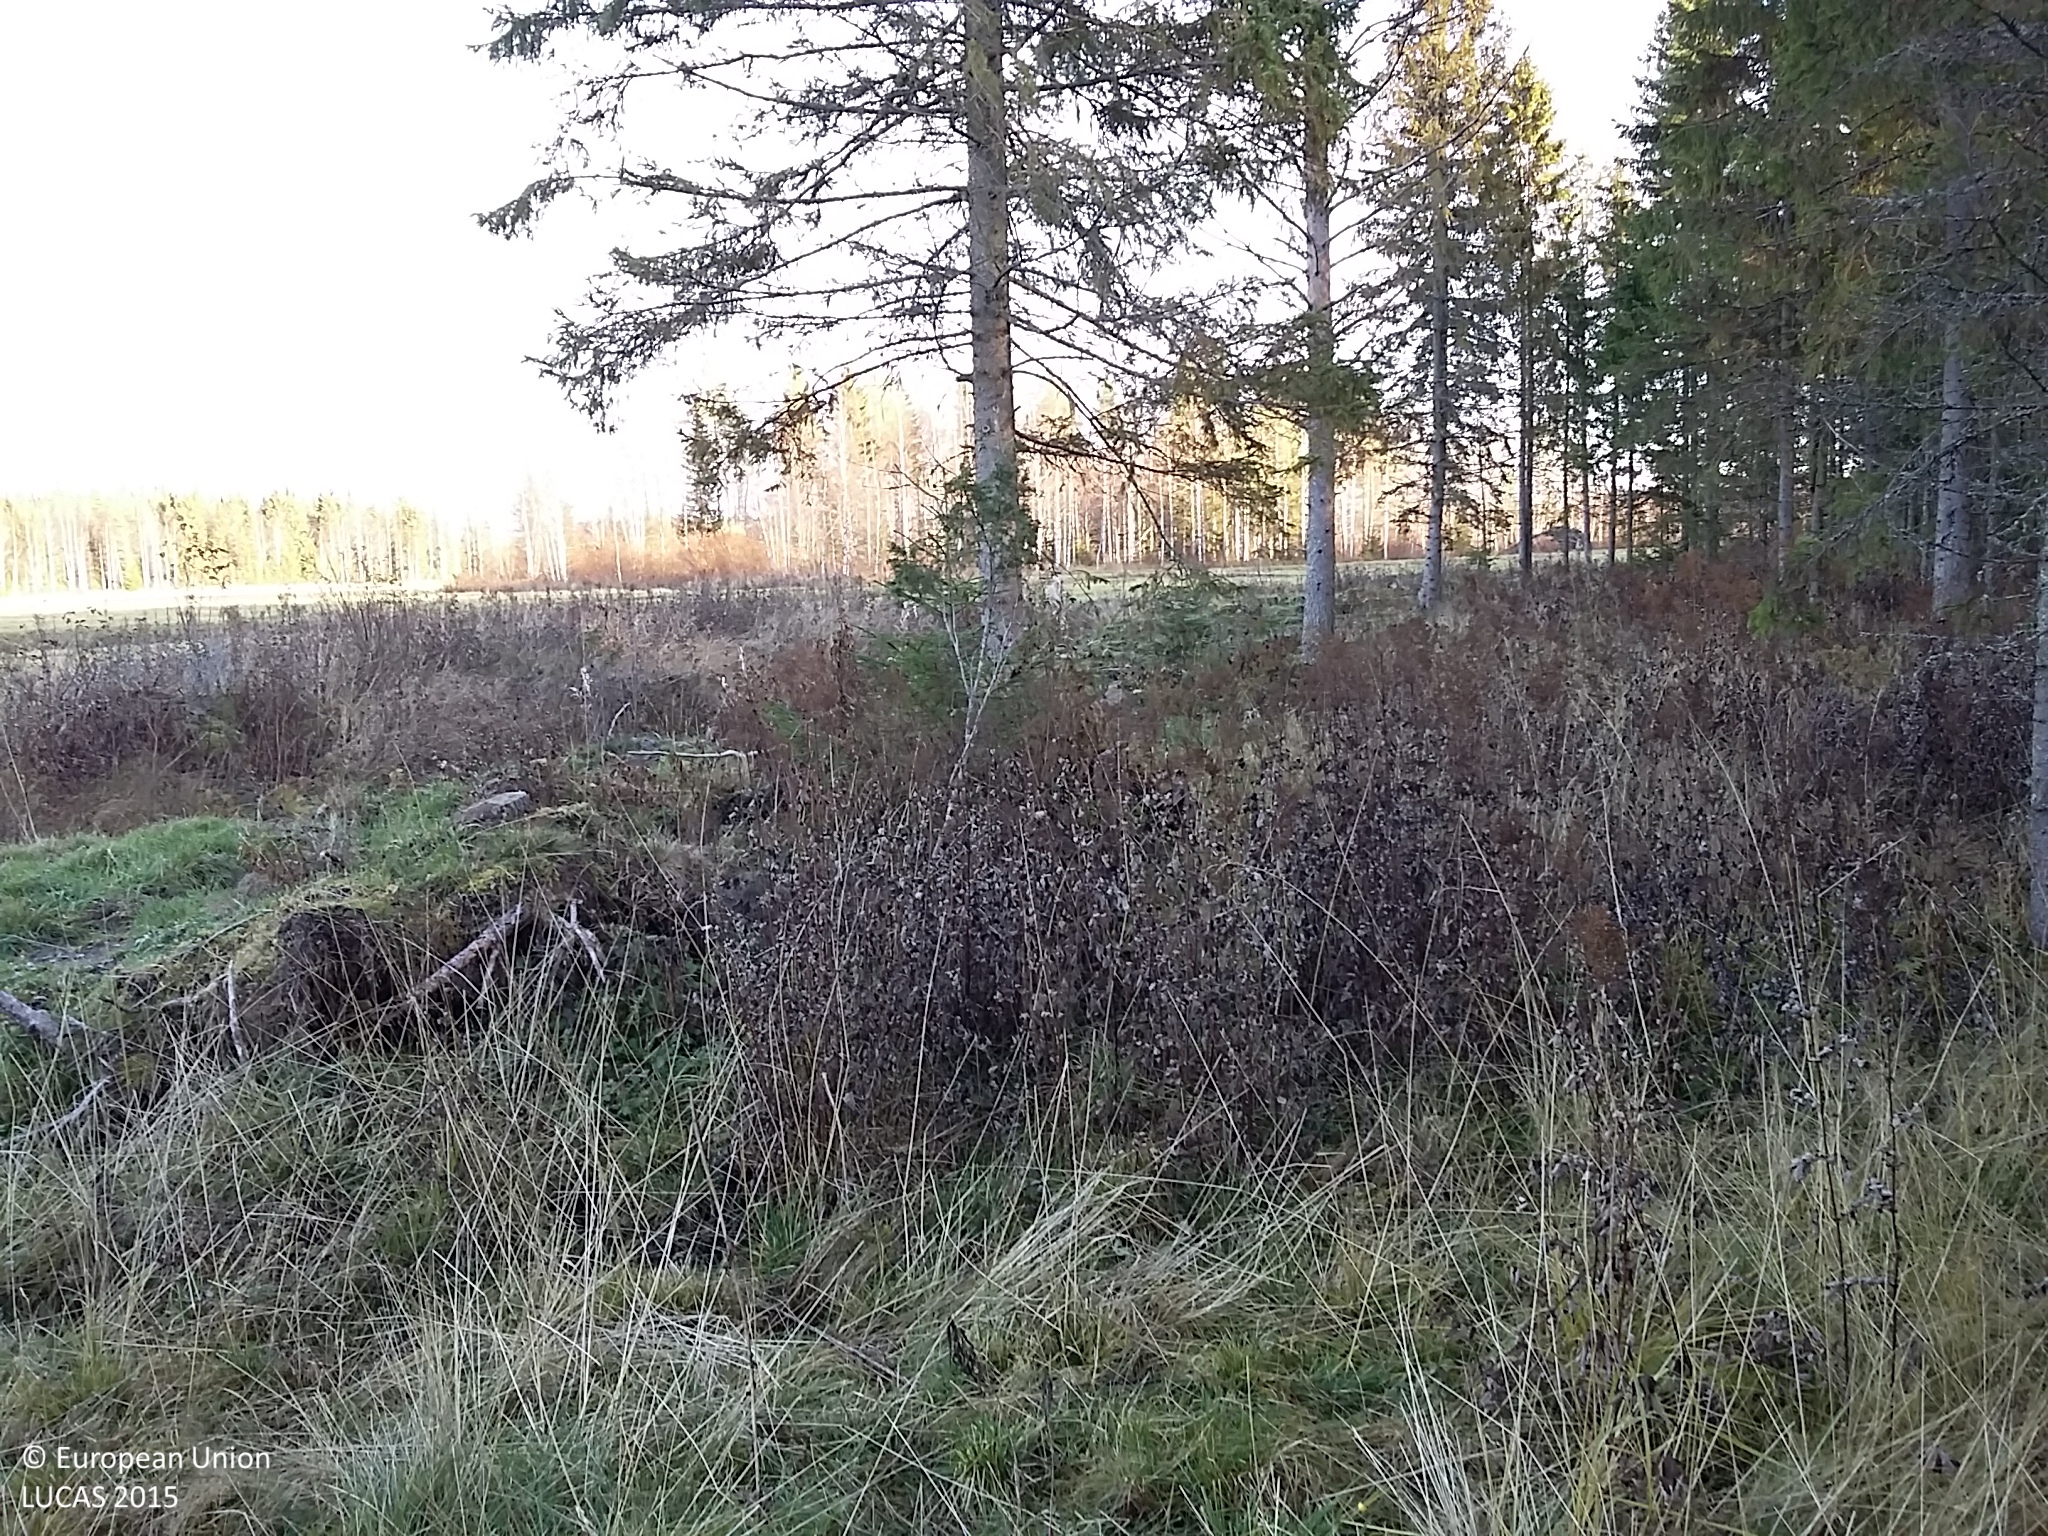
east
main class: Woodland
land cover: Spruce dominated coniferous woodland
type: boreal forest
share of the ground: 25 - 50 %
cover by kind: coniferous forest trees 40 %, shrubs 20 %, herbaceous plants 20 %, lichens and mosses 20 %
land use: Forestry
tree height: > 5 m
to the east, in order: Spruce dominated coniferous woodland; Ditches and canals; Spontaneously vegetated surfaces; Temporary grasslands; Ditches and canals; Temporary grasslands; Ditches and canals; Grass margins; Tracks; Grass margins; Ditches and canals; Grass margins; Temporary grasslands; Ditches and canals; Shrubland with sparse tree cover; Broadleaved woodland; Ditches and canals; Broadleaved woodland; Ditches and canals; Broadleaved woodland; Ditches and canals; Shruby margins; Temporary grasslands
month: October
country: FI
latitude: 64.2089
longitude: 25.0597
